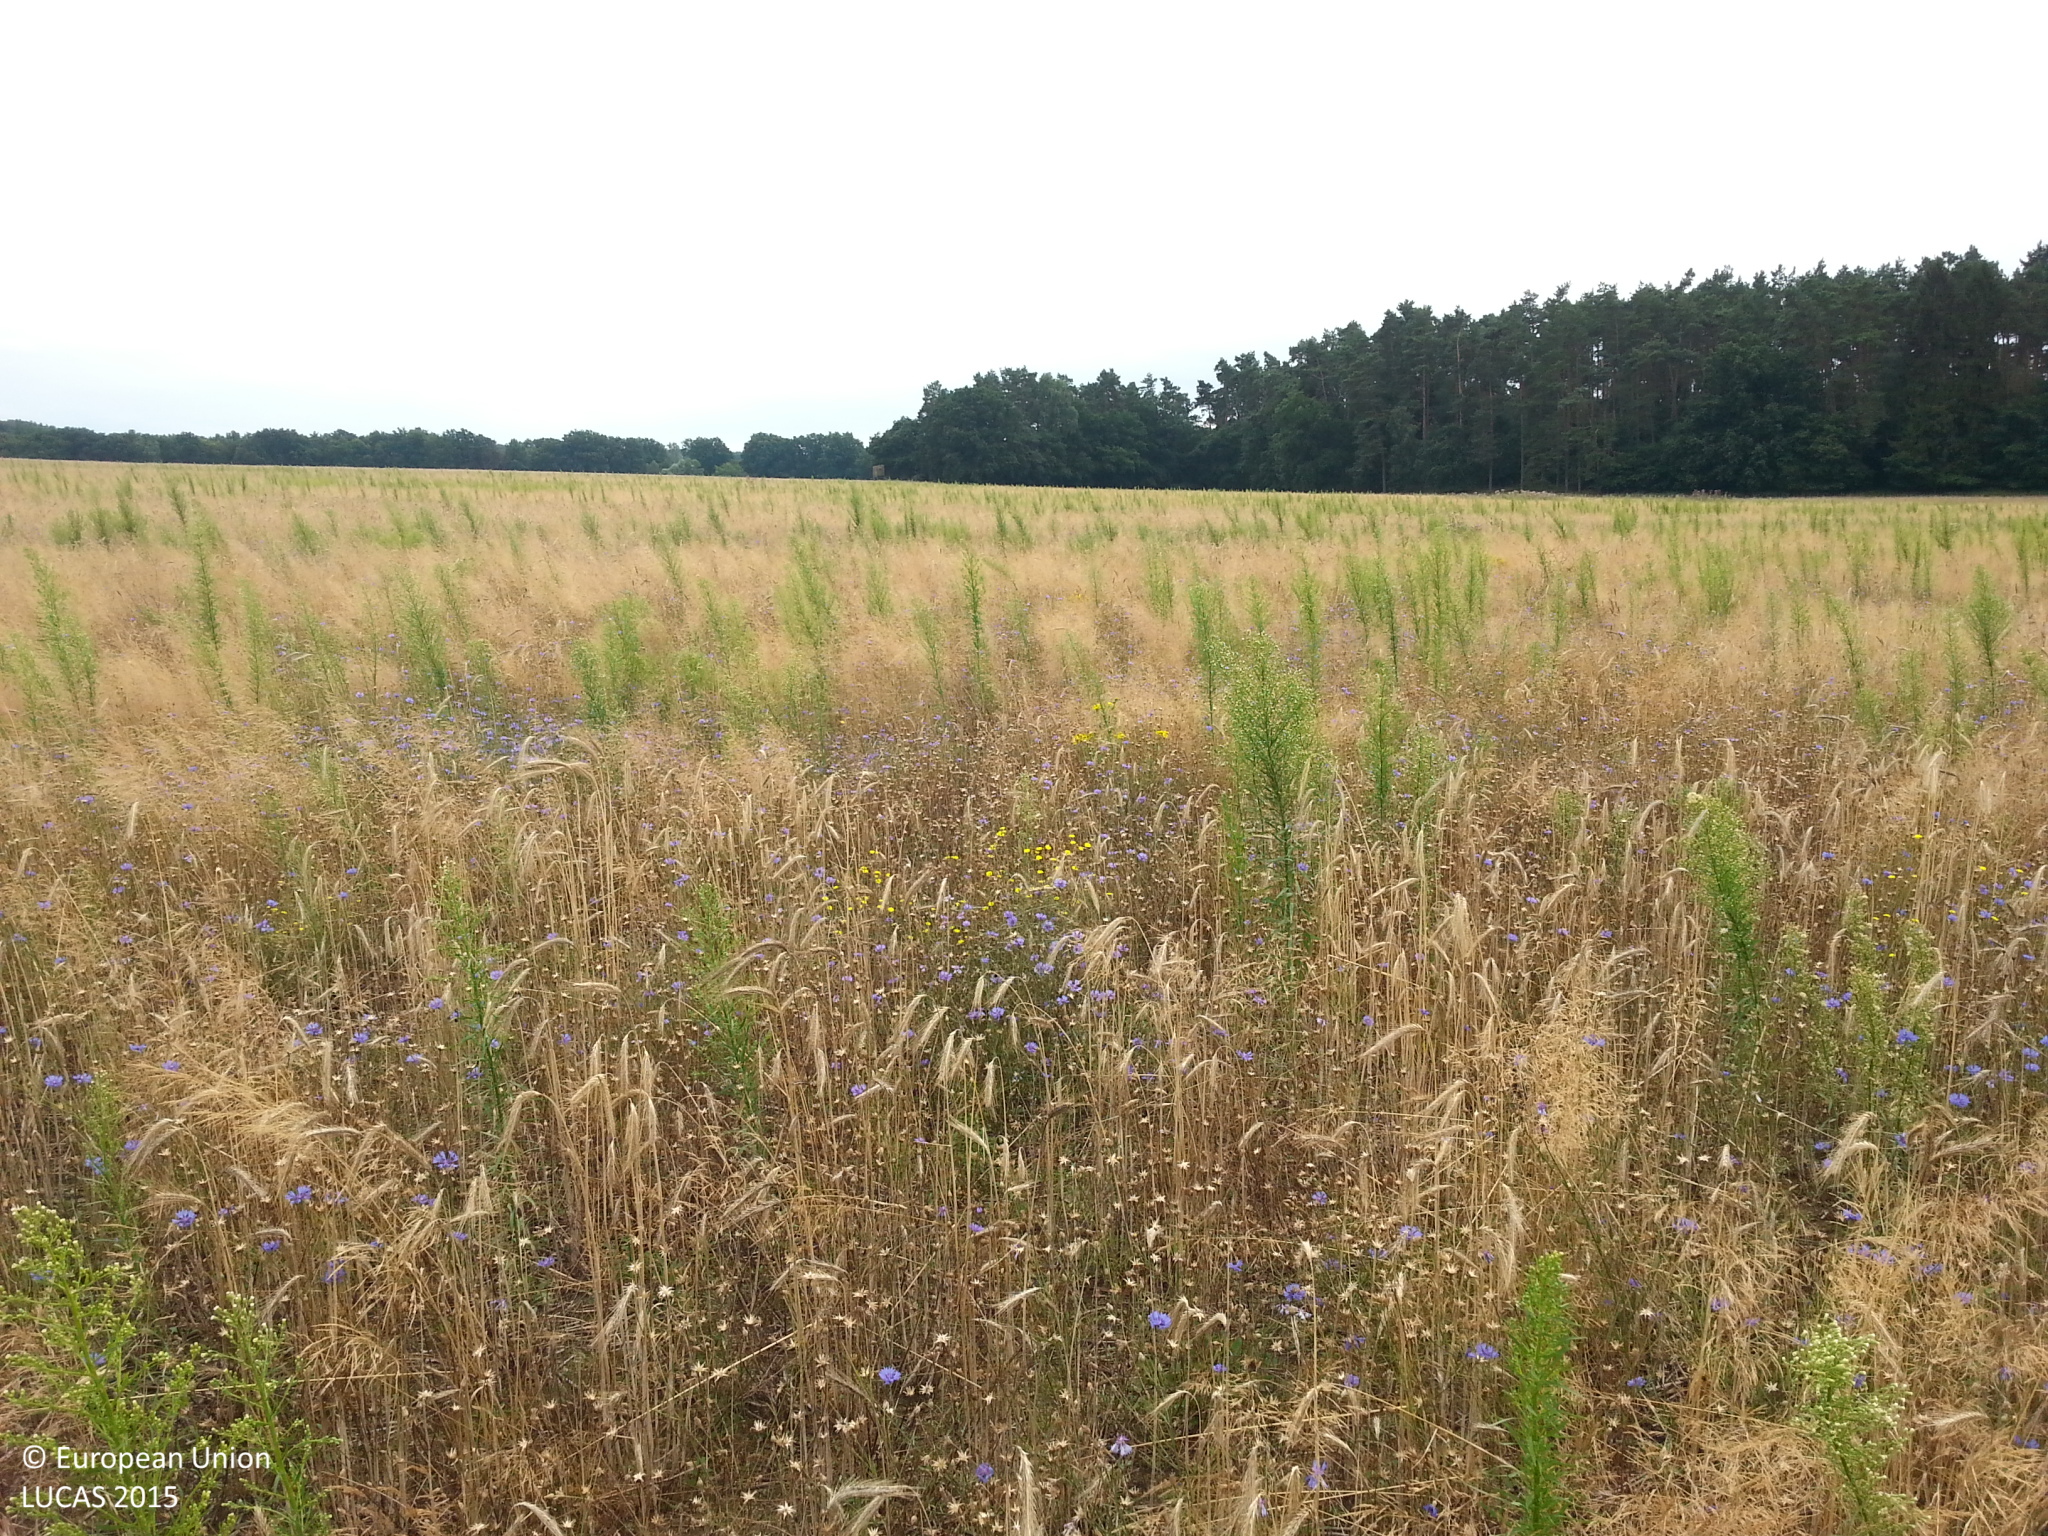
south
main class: Cropland
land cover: Rye
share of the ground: > 75 %
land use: Agriculture (excluding fallow land and kitchen gardens)
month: July
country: DE
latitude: 53.2874
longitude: 12.4444
